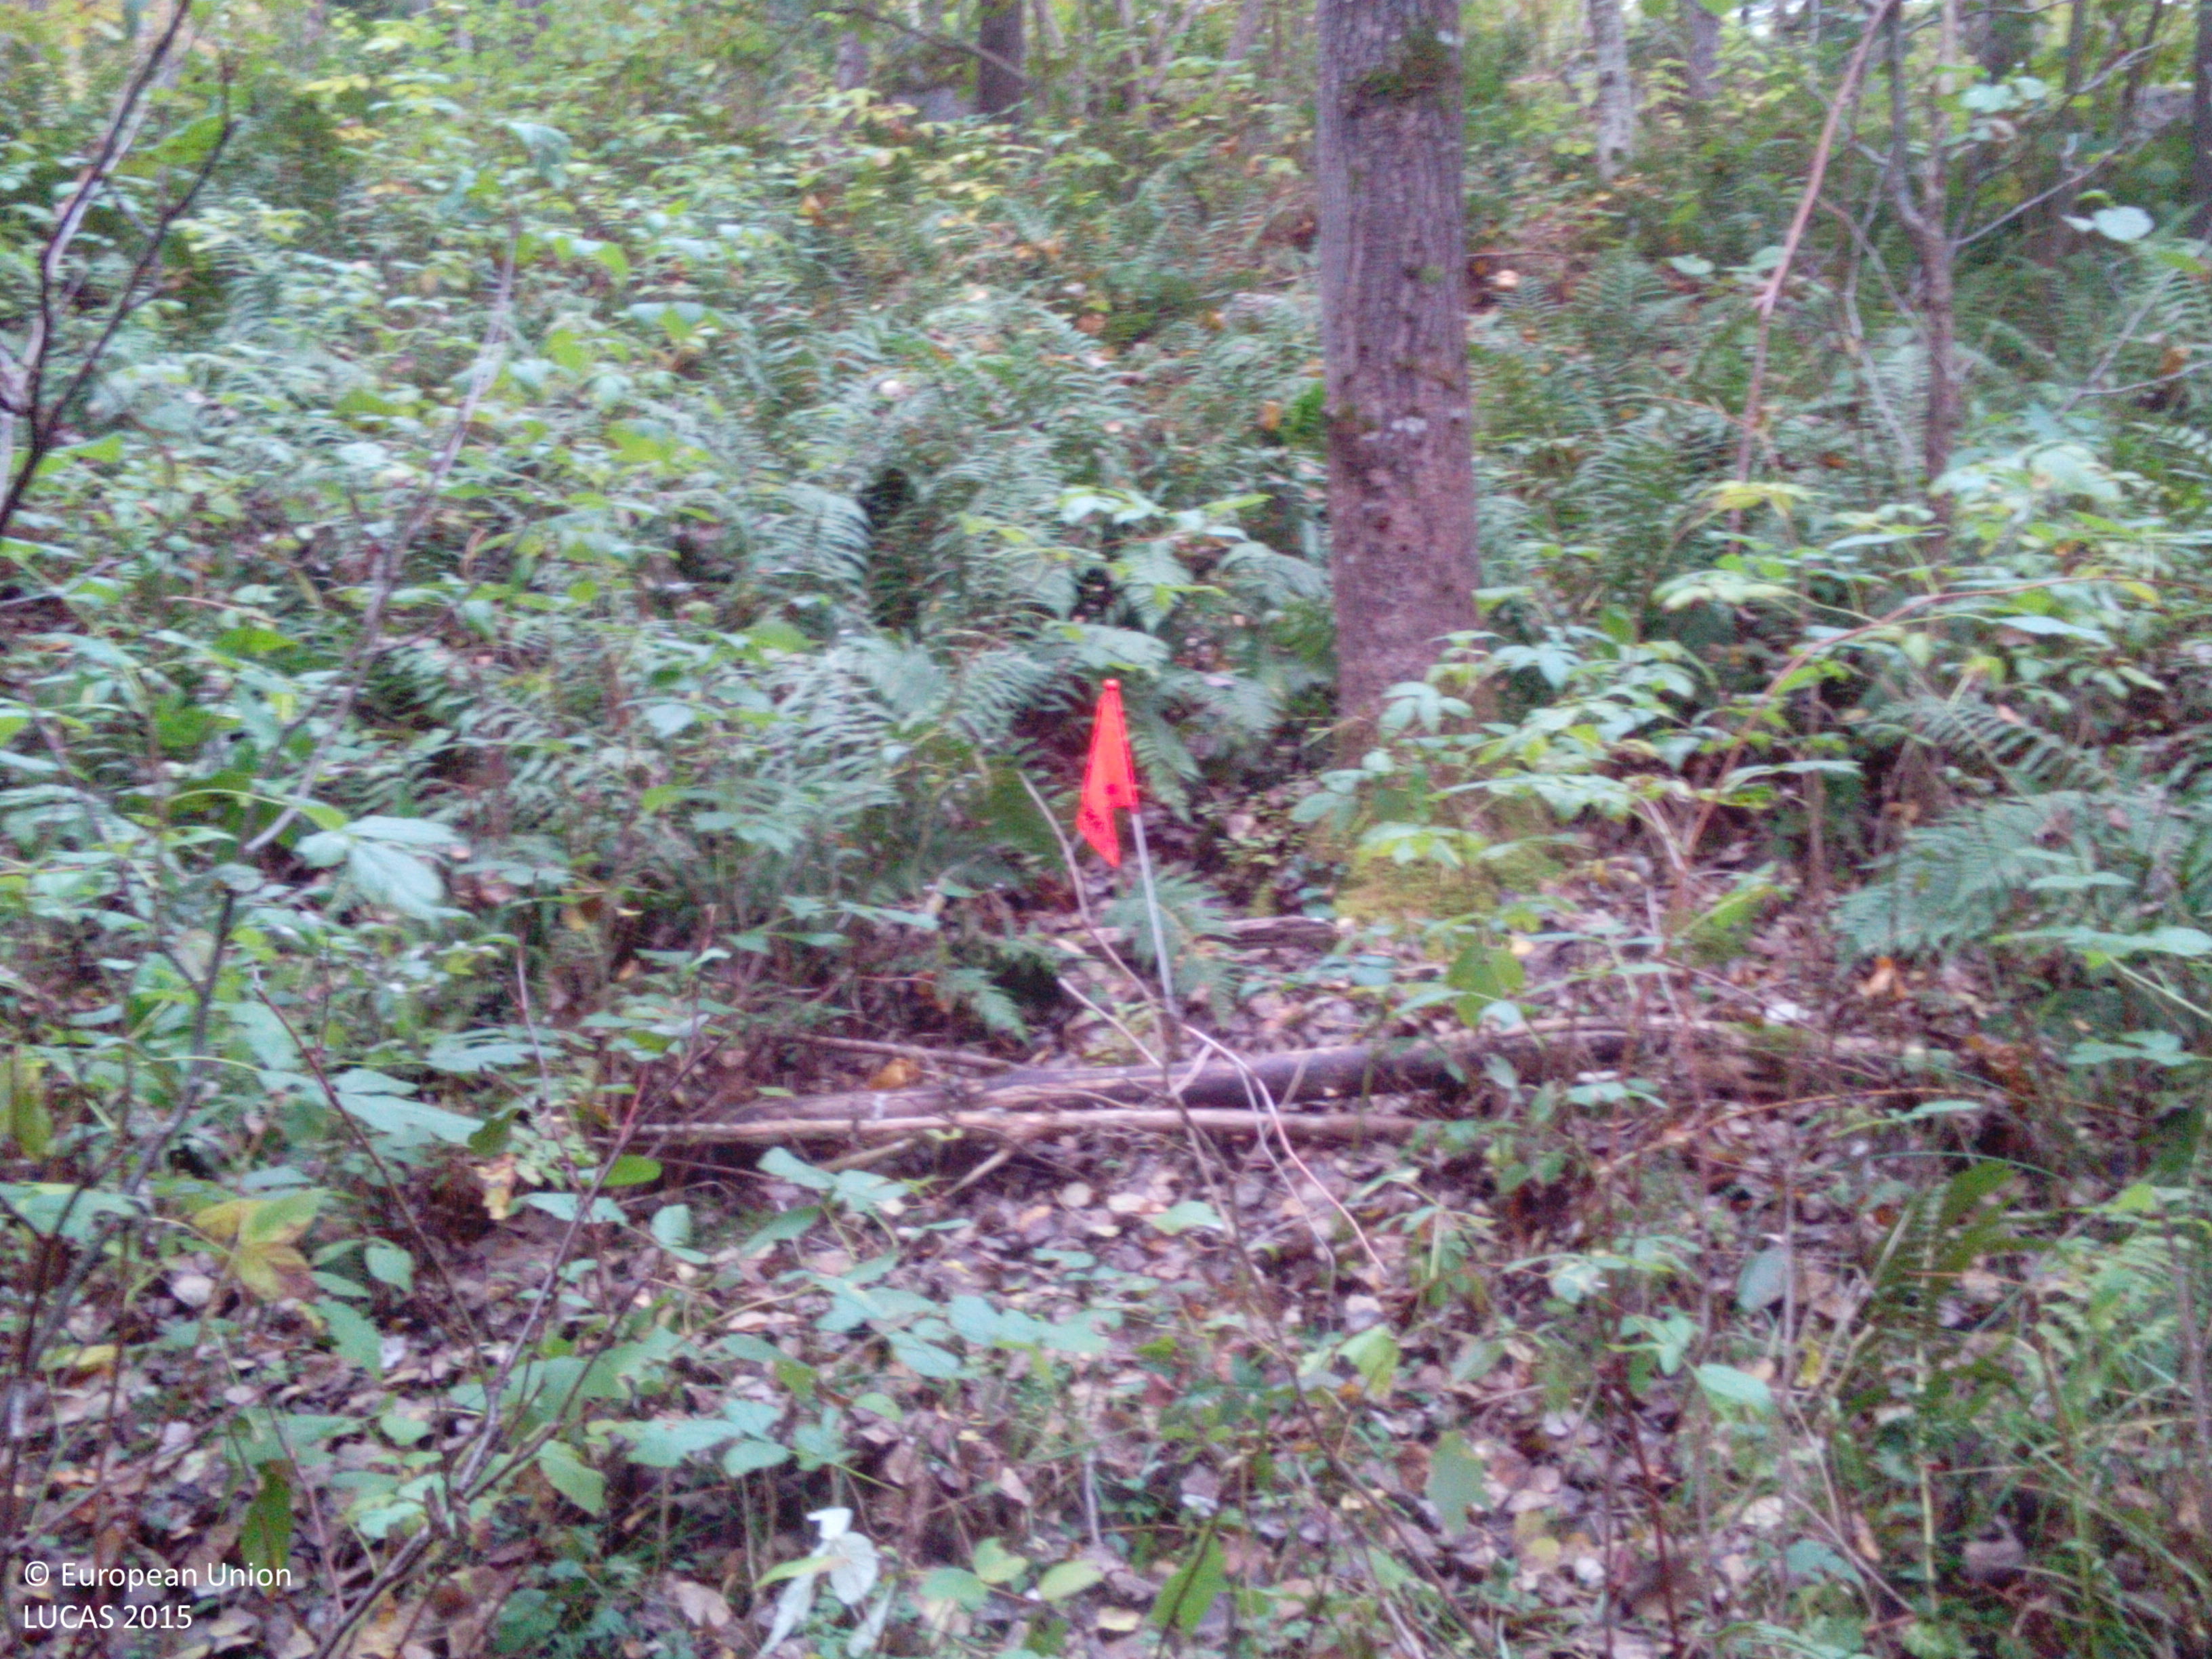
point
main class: Woodland
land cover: Broadleaved woodland
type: hemiboreal forest and nemoral coniferous forest and mixed broadleaved-coniferous forest
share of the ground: > 75 %
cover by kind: broadleaved forest trees 80 %, shrubs 10 %, herbaceous plants 10 %
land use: Forestry
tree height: > 5 m
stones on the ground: 25 - 50 %
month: October
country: SE
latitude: 58.8211
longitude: 16.4891
